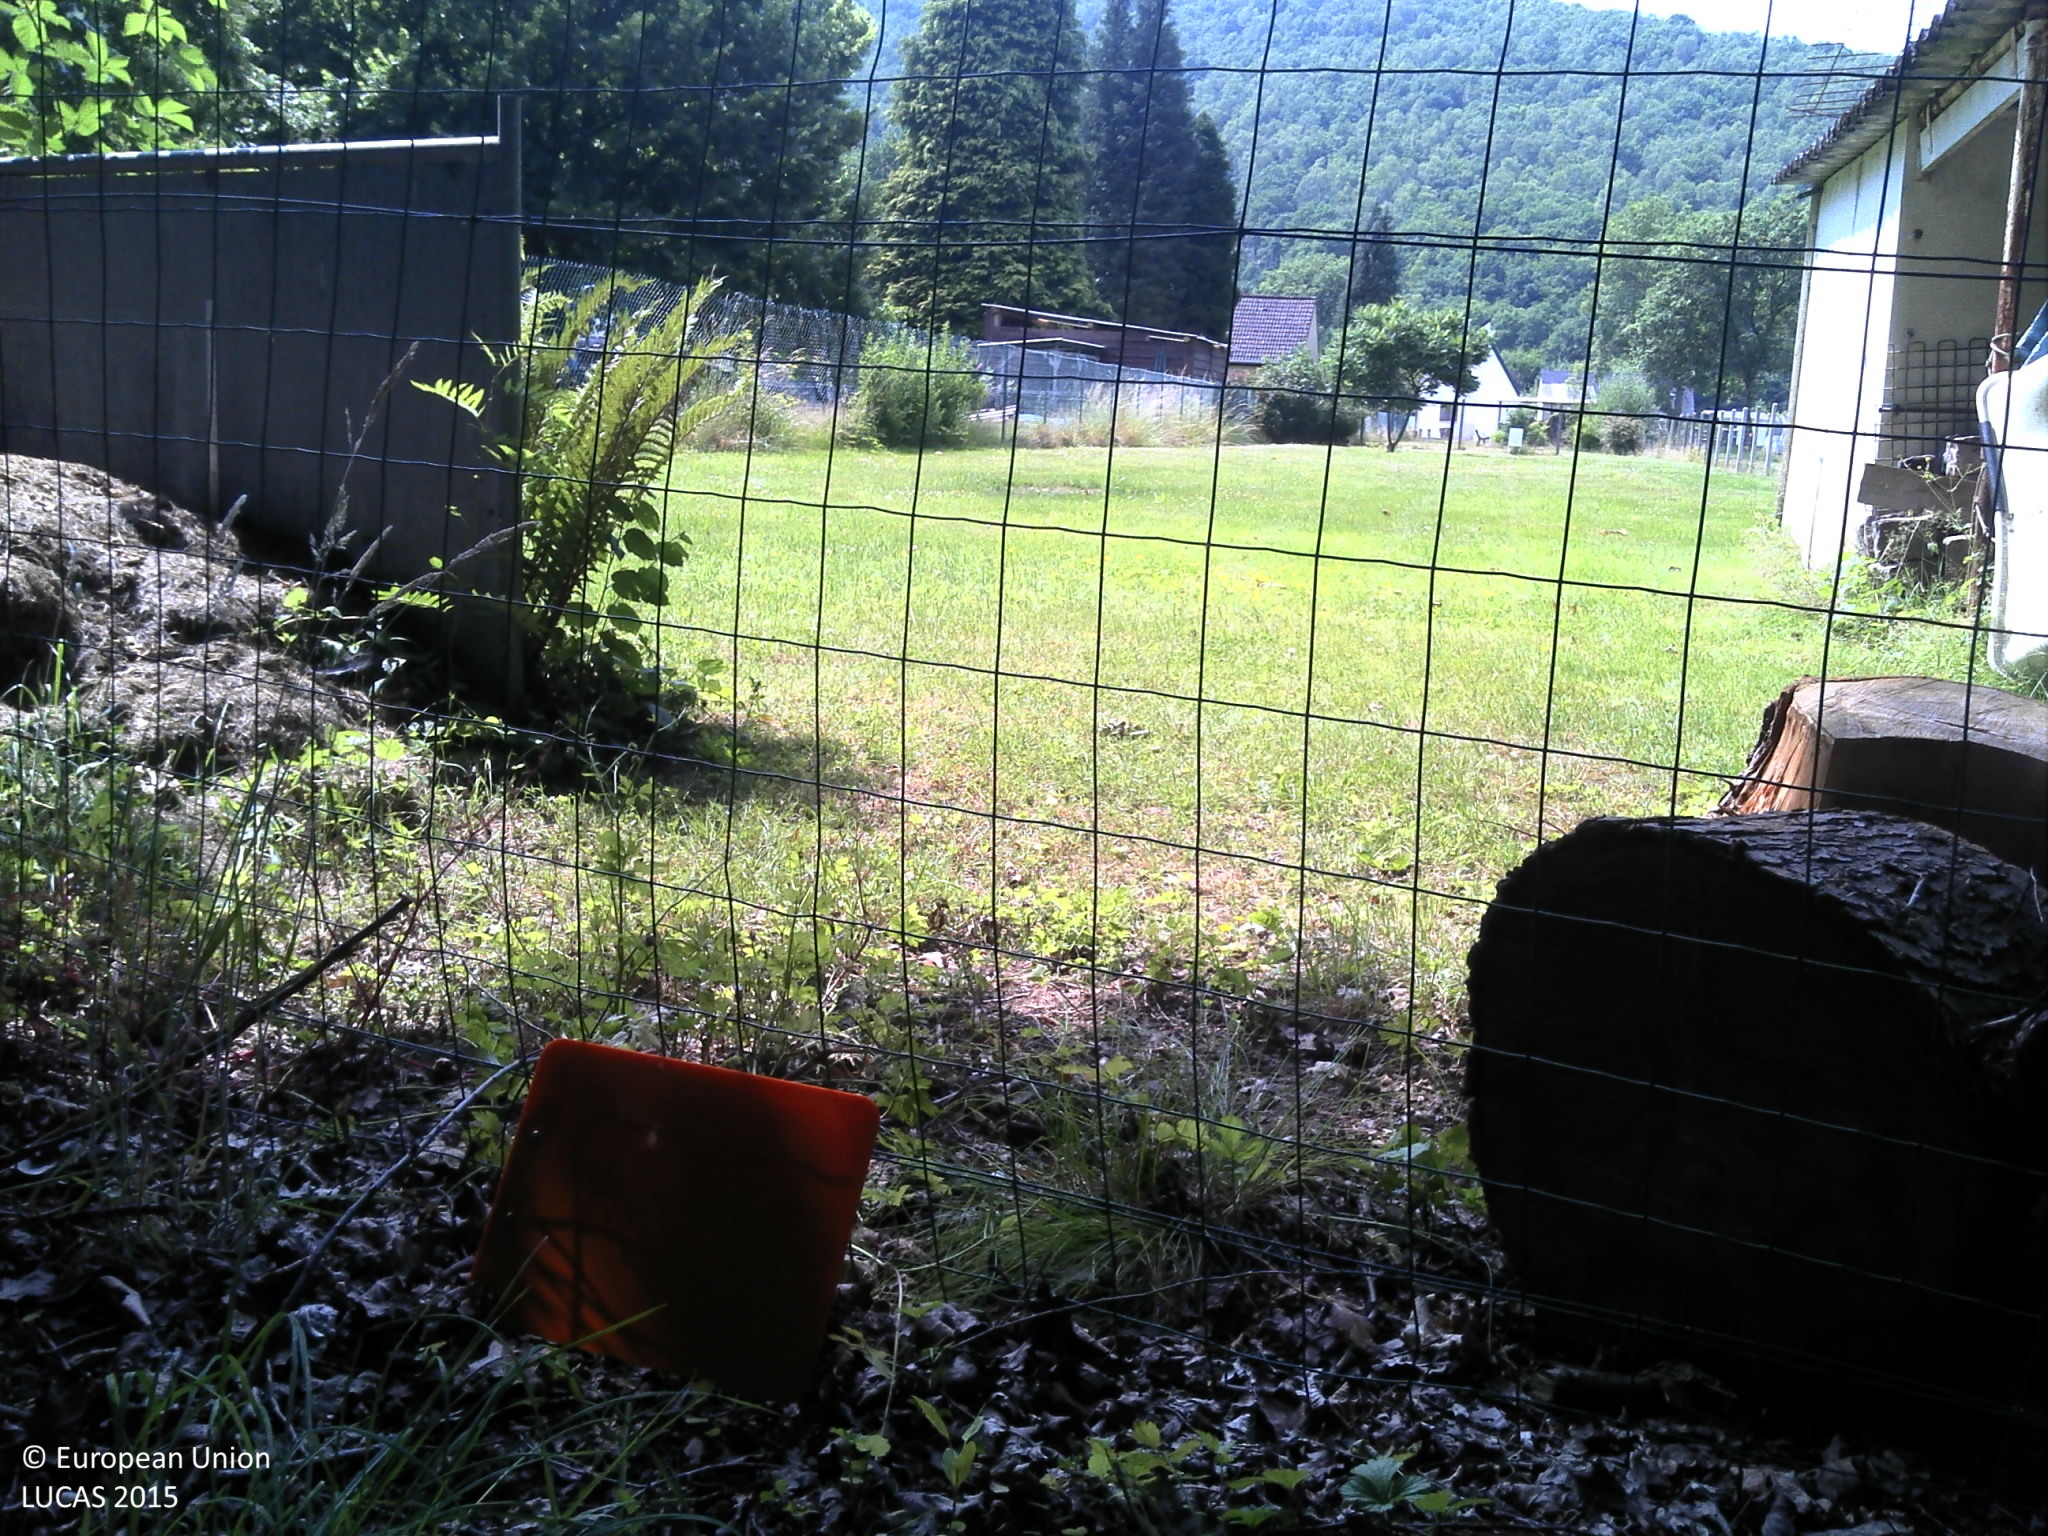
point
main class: Grassland
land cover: Grassland without tree/shrub cover
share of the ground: > 75 %
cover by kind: herbaceous plants 100 %
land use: Amenities, museums, leisure
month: July
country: FR
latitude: 49.8678
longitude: 4.8074
